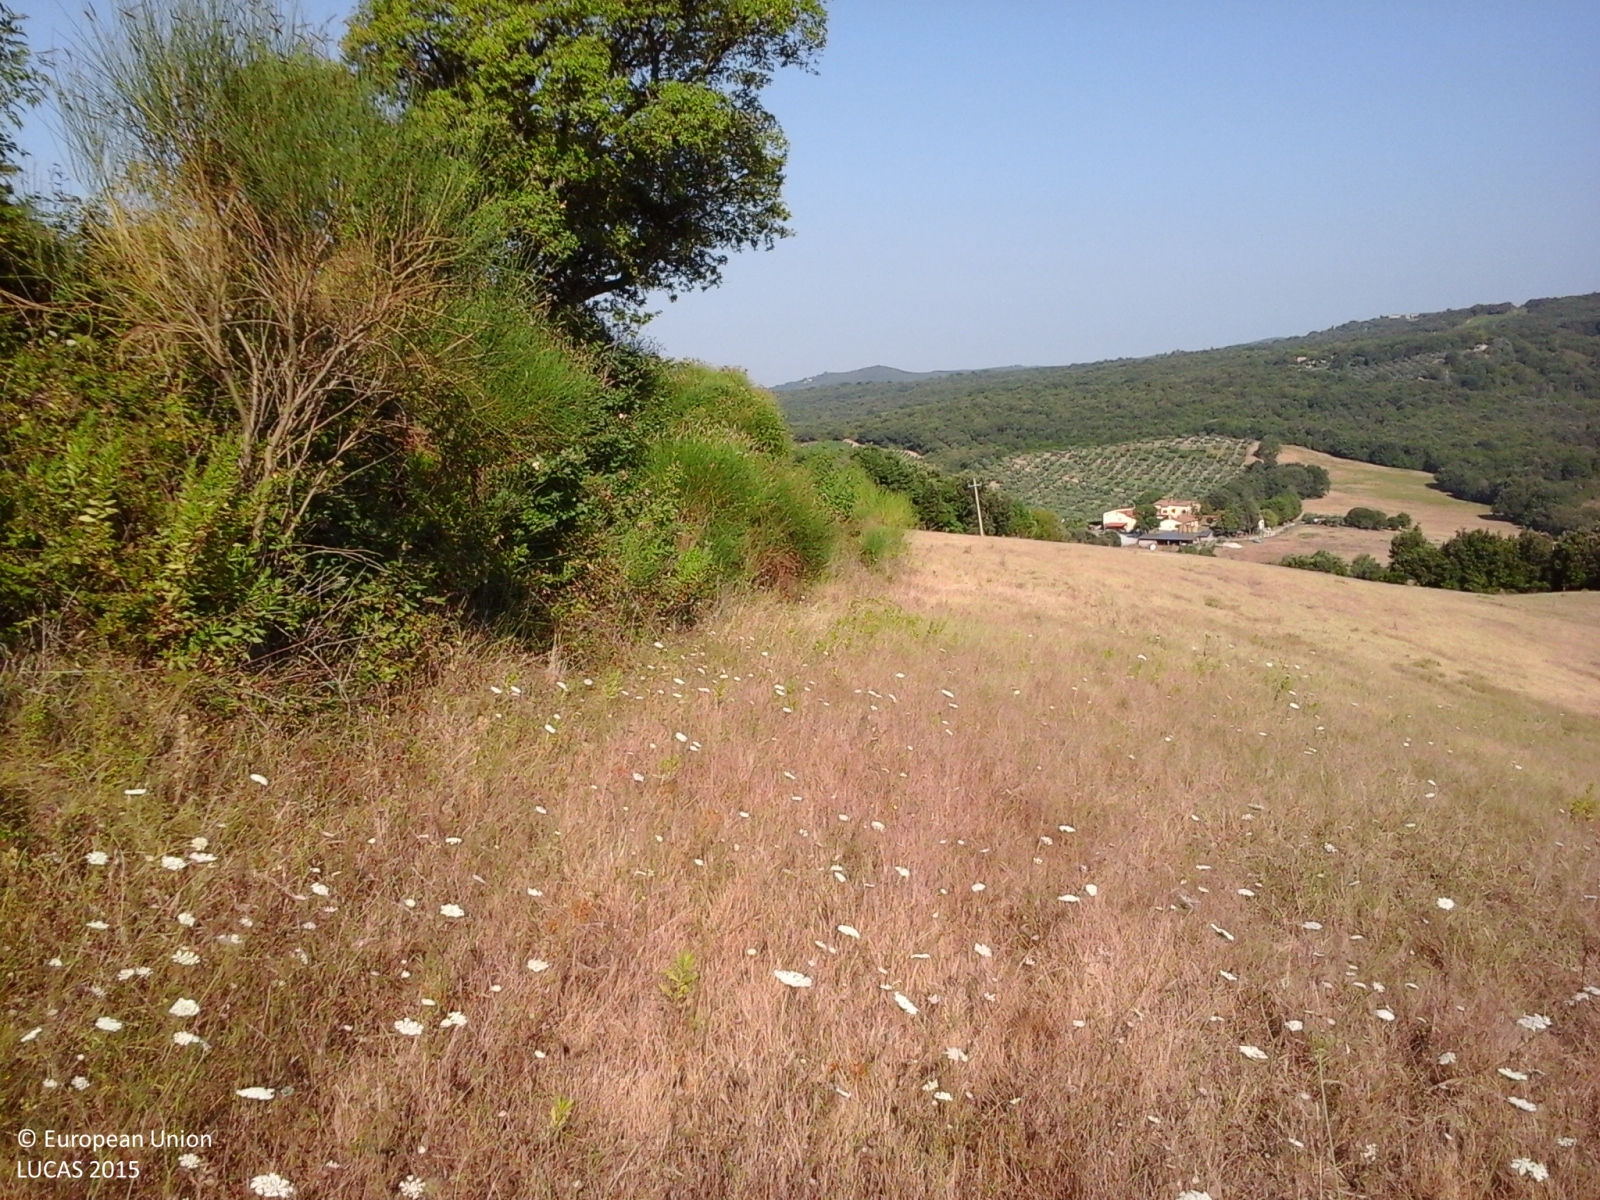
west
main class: Woodland
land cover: Broadleaved woodland
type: thermophilous deciduous forest
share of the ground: > 75 %
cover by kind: broadleaved forest trees 70 %, shrubs 25 %, herbaceous plants 5 %
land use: Forestry
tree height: > 5 m
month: July
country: IT
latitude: 42.9908
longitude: 11.1371
